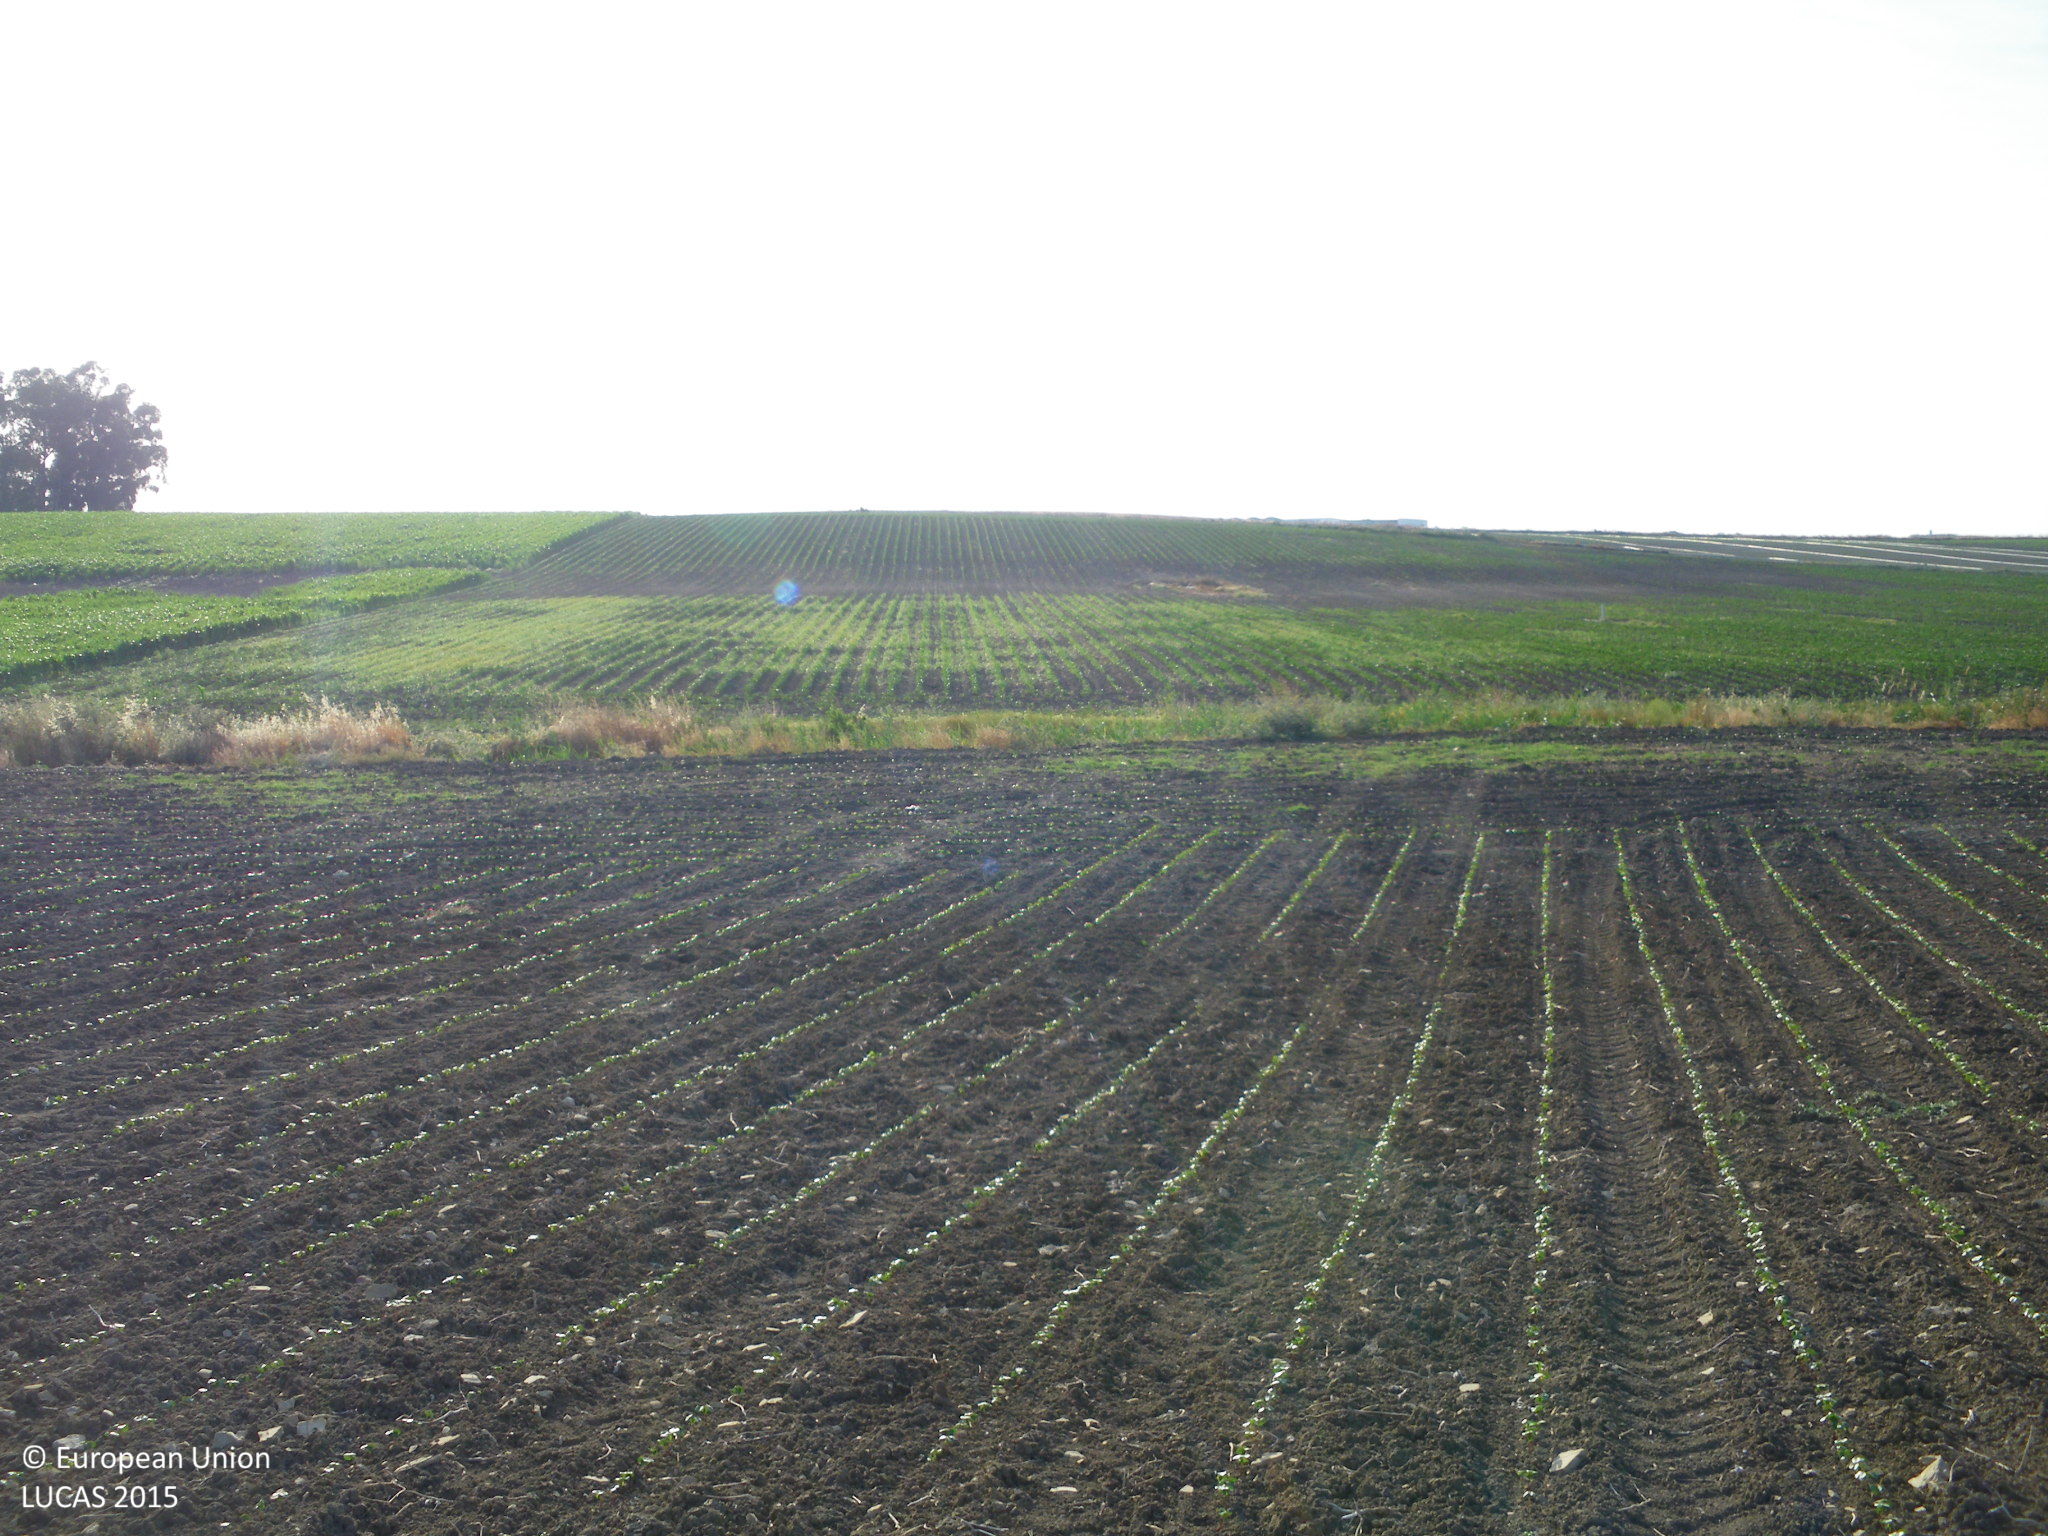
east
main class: Cropland
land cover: Cotton
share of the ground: < 10 %
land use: Agriculture (excluding fallow land and kitchen gardens)
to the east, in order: Cotton; Grass margins; Rivers and streams; Grassland without tree/shrub cover; Cotton; Tracks; Grass margins; Cotton
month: June
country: ES
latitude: 36.6466
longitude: -6.2888
